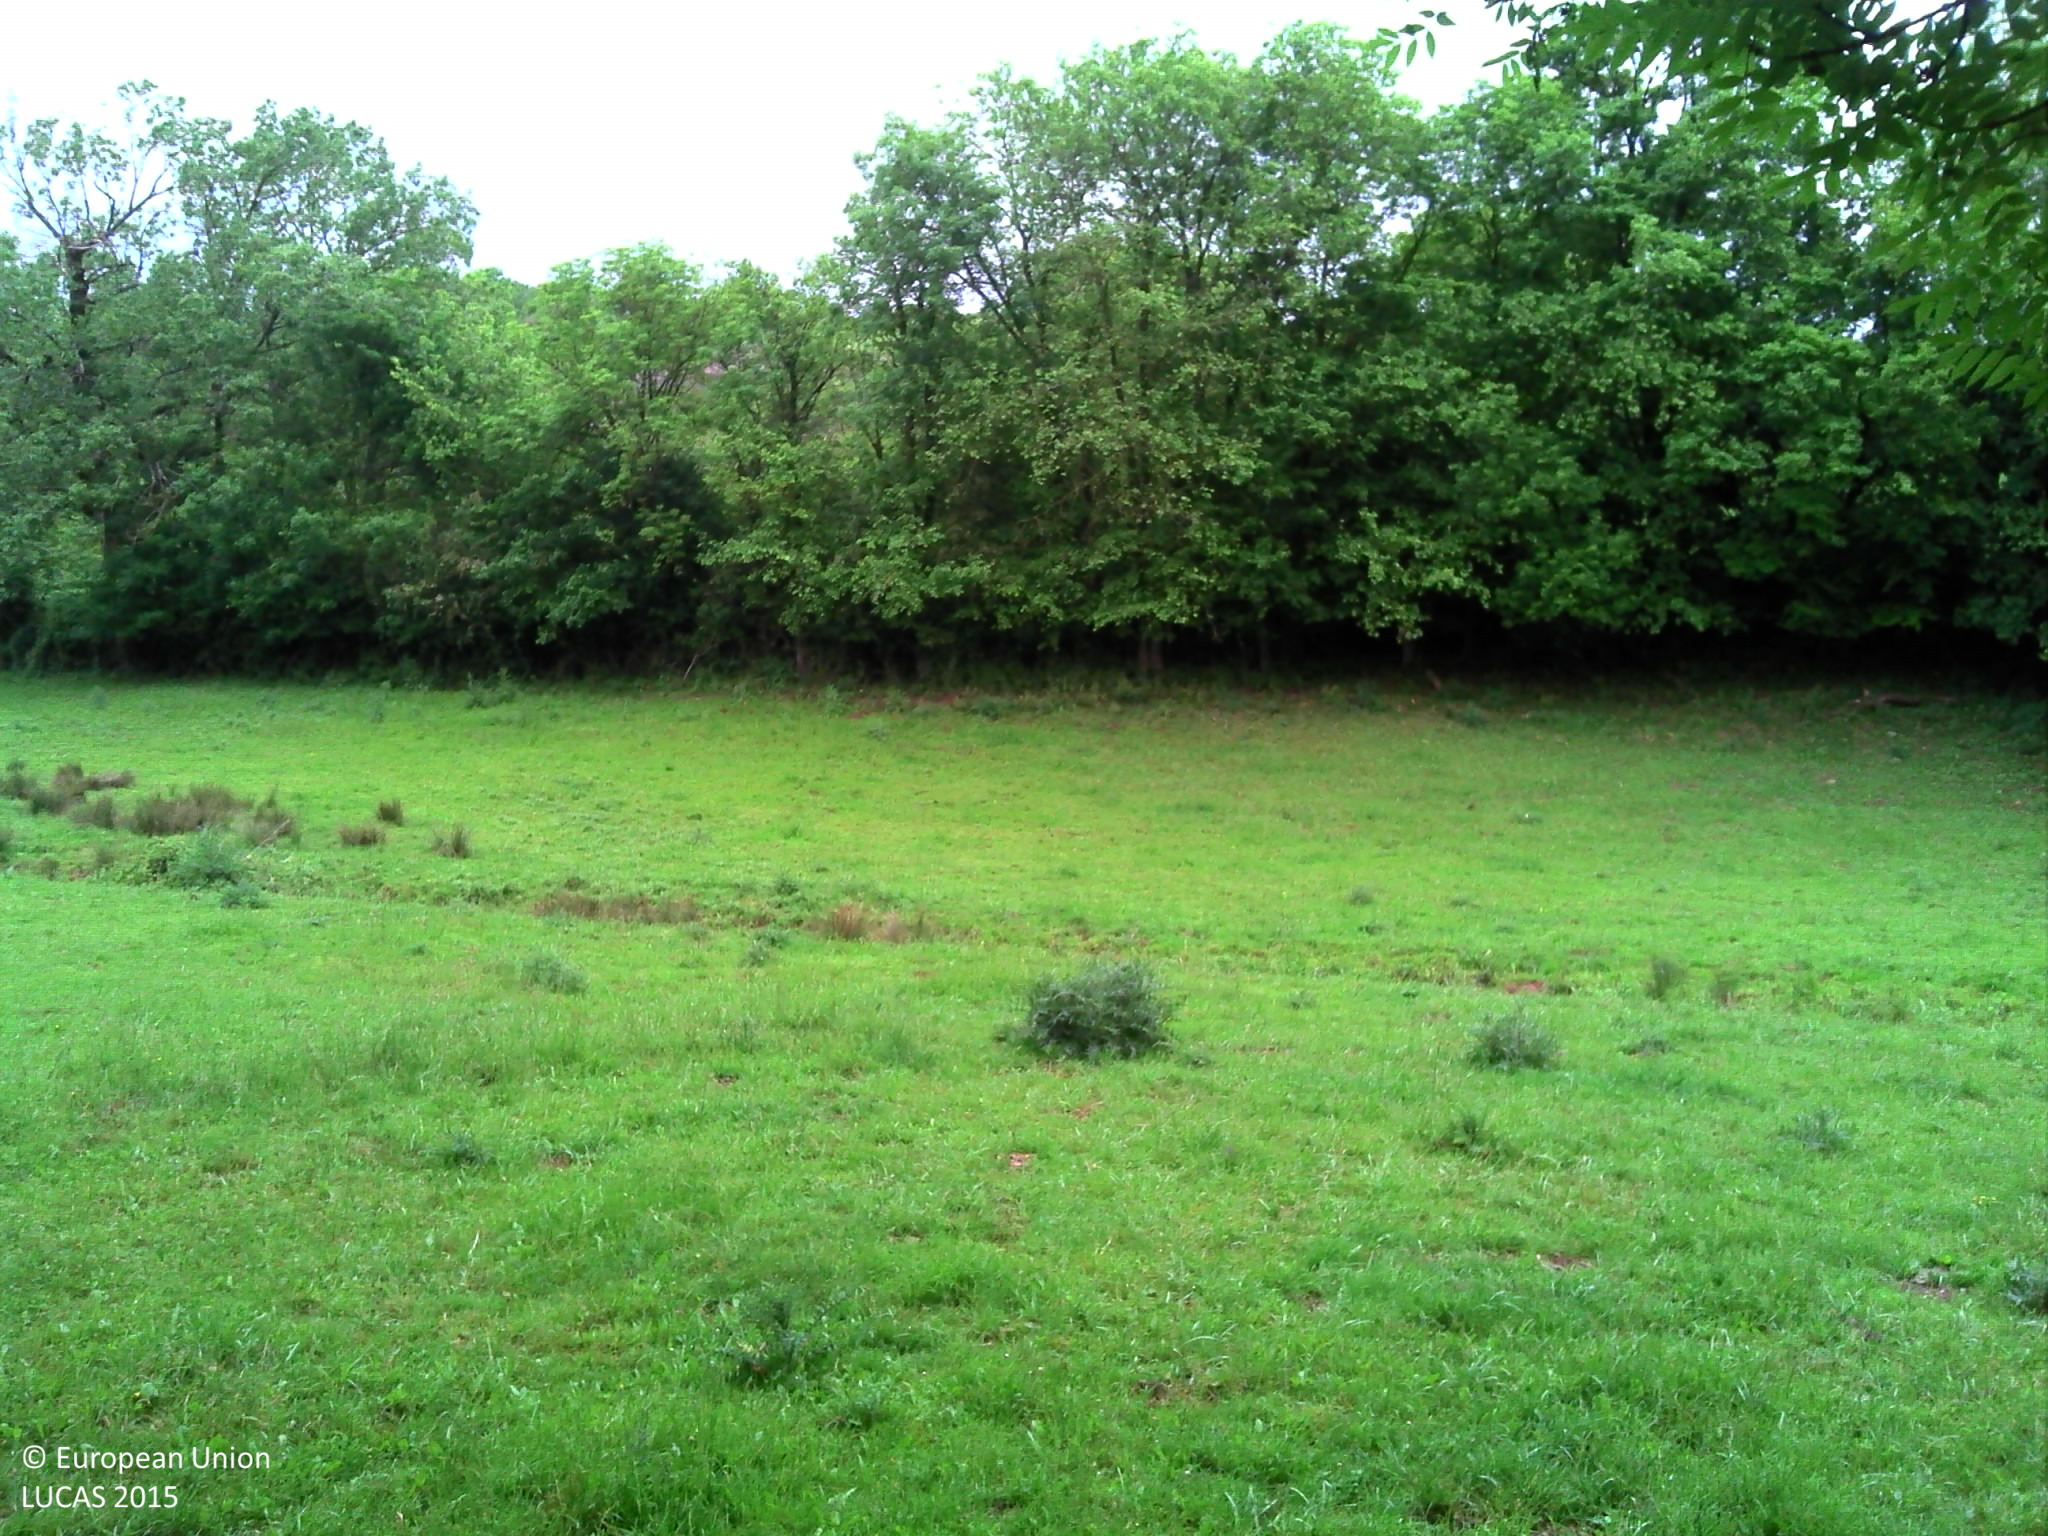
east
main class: Woodland
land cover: Broadleaved woodland
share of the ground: > 75 %
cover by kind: broadleaved forest trees 85 %, shrubs 10 %, lichens and mosses 5 %
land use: Forestry
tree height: > 5 m
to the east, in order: Broadleaved woodland; Grassland without tree/shrub cover; Rivers and streams; Grassland without tree/shrub cover; Broadleaved woodland; Fences; Broadleaved woodland; Fences; Clovers; Broadleaved woodland; Clovers; Fences; Lines of trees; Tracks; Grass margins; Electric lines; Tracks; Lines of trees; Fences; Barley
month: May
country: FR
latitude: 44.3650
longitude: 2.9650
